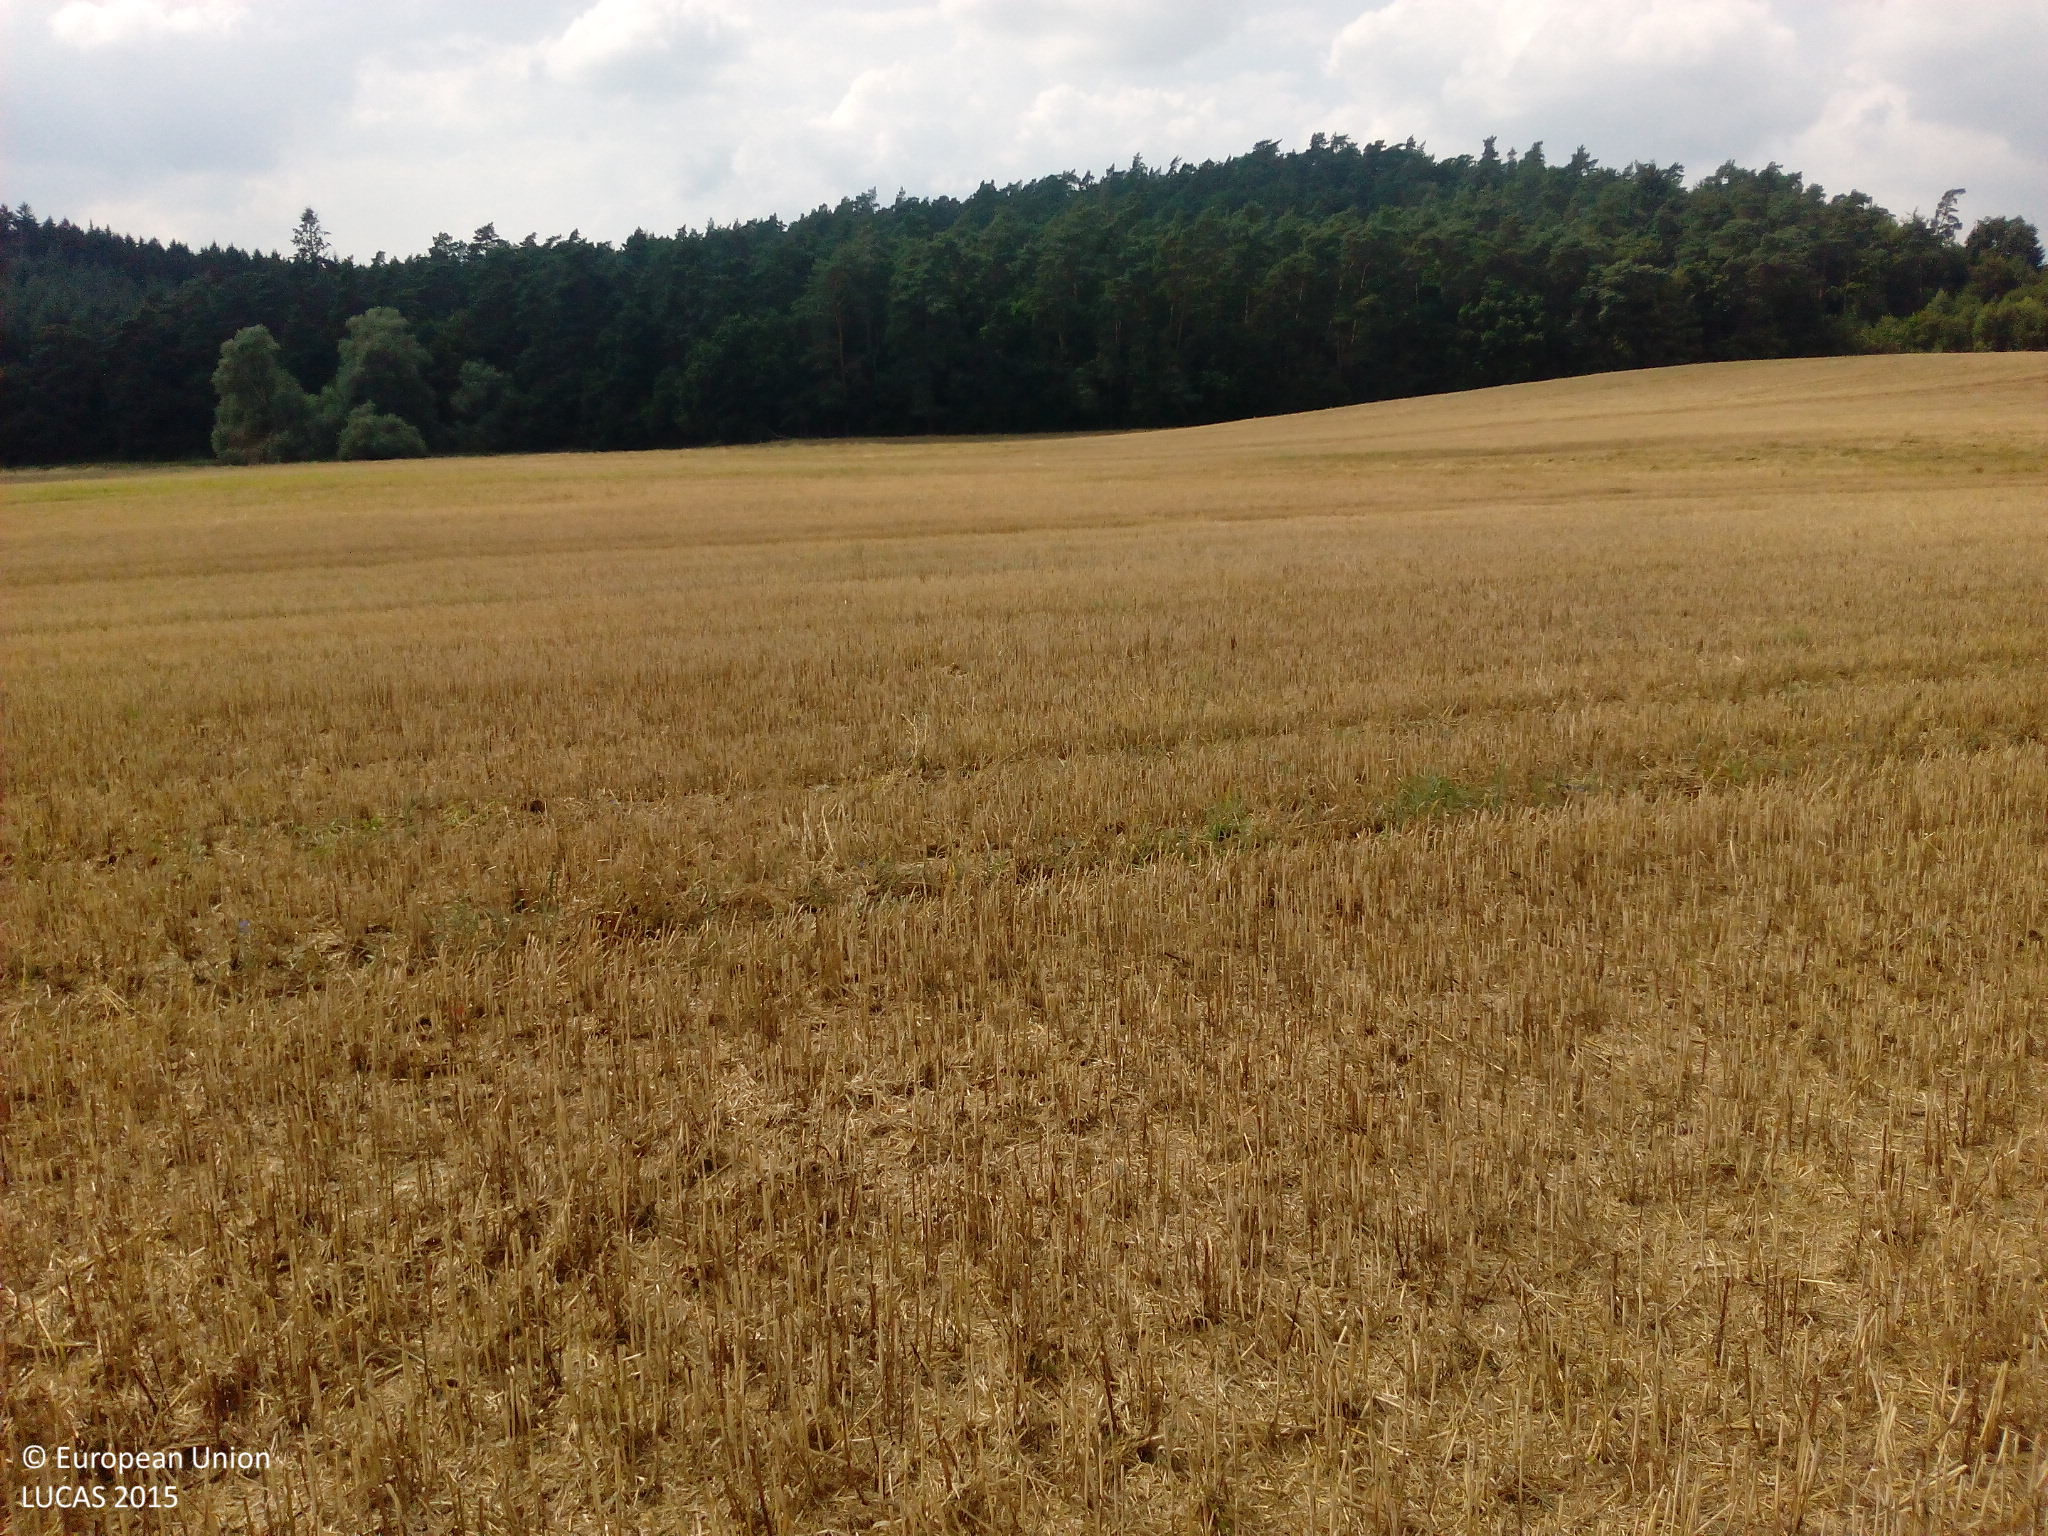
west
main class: Cropland
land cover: Common wheat
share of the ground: < 10 %
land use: Agriculture (excluding fallow land and kitchen gardens)
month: August
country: DE
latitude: 53.7159
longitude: 12.5903
